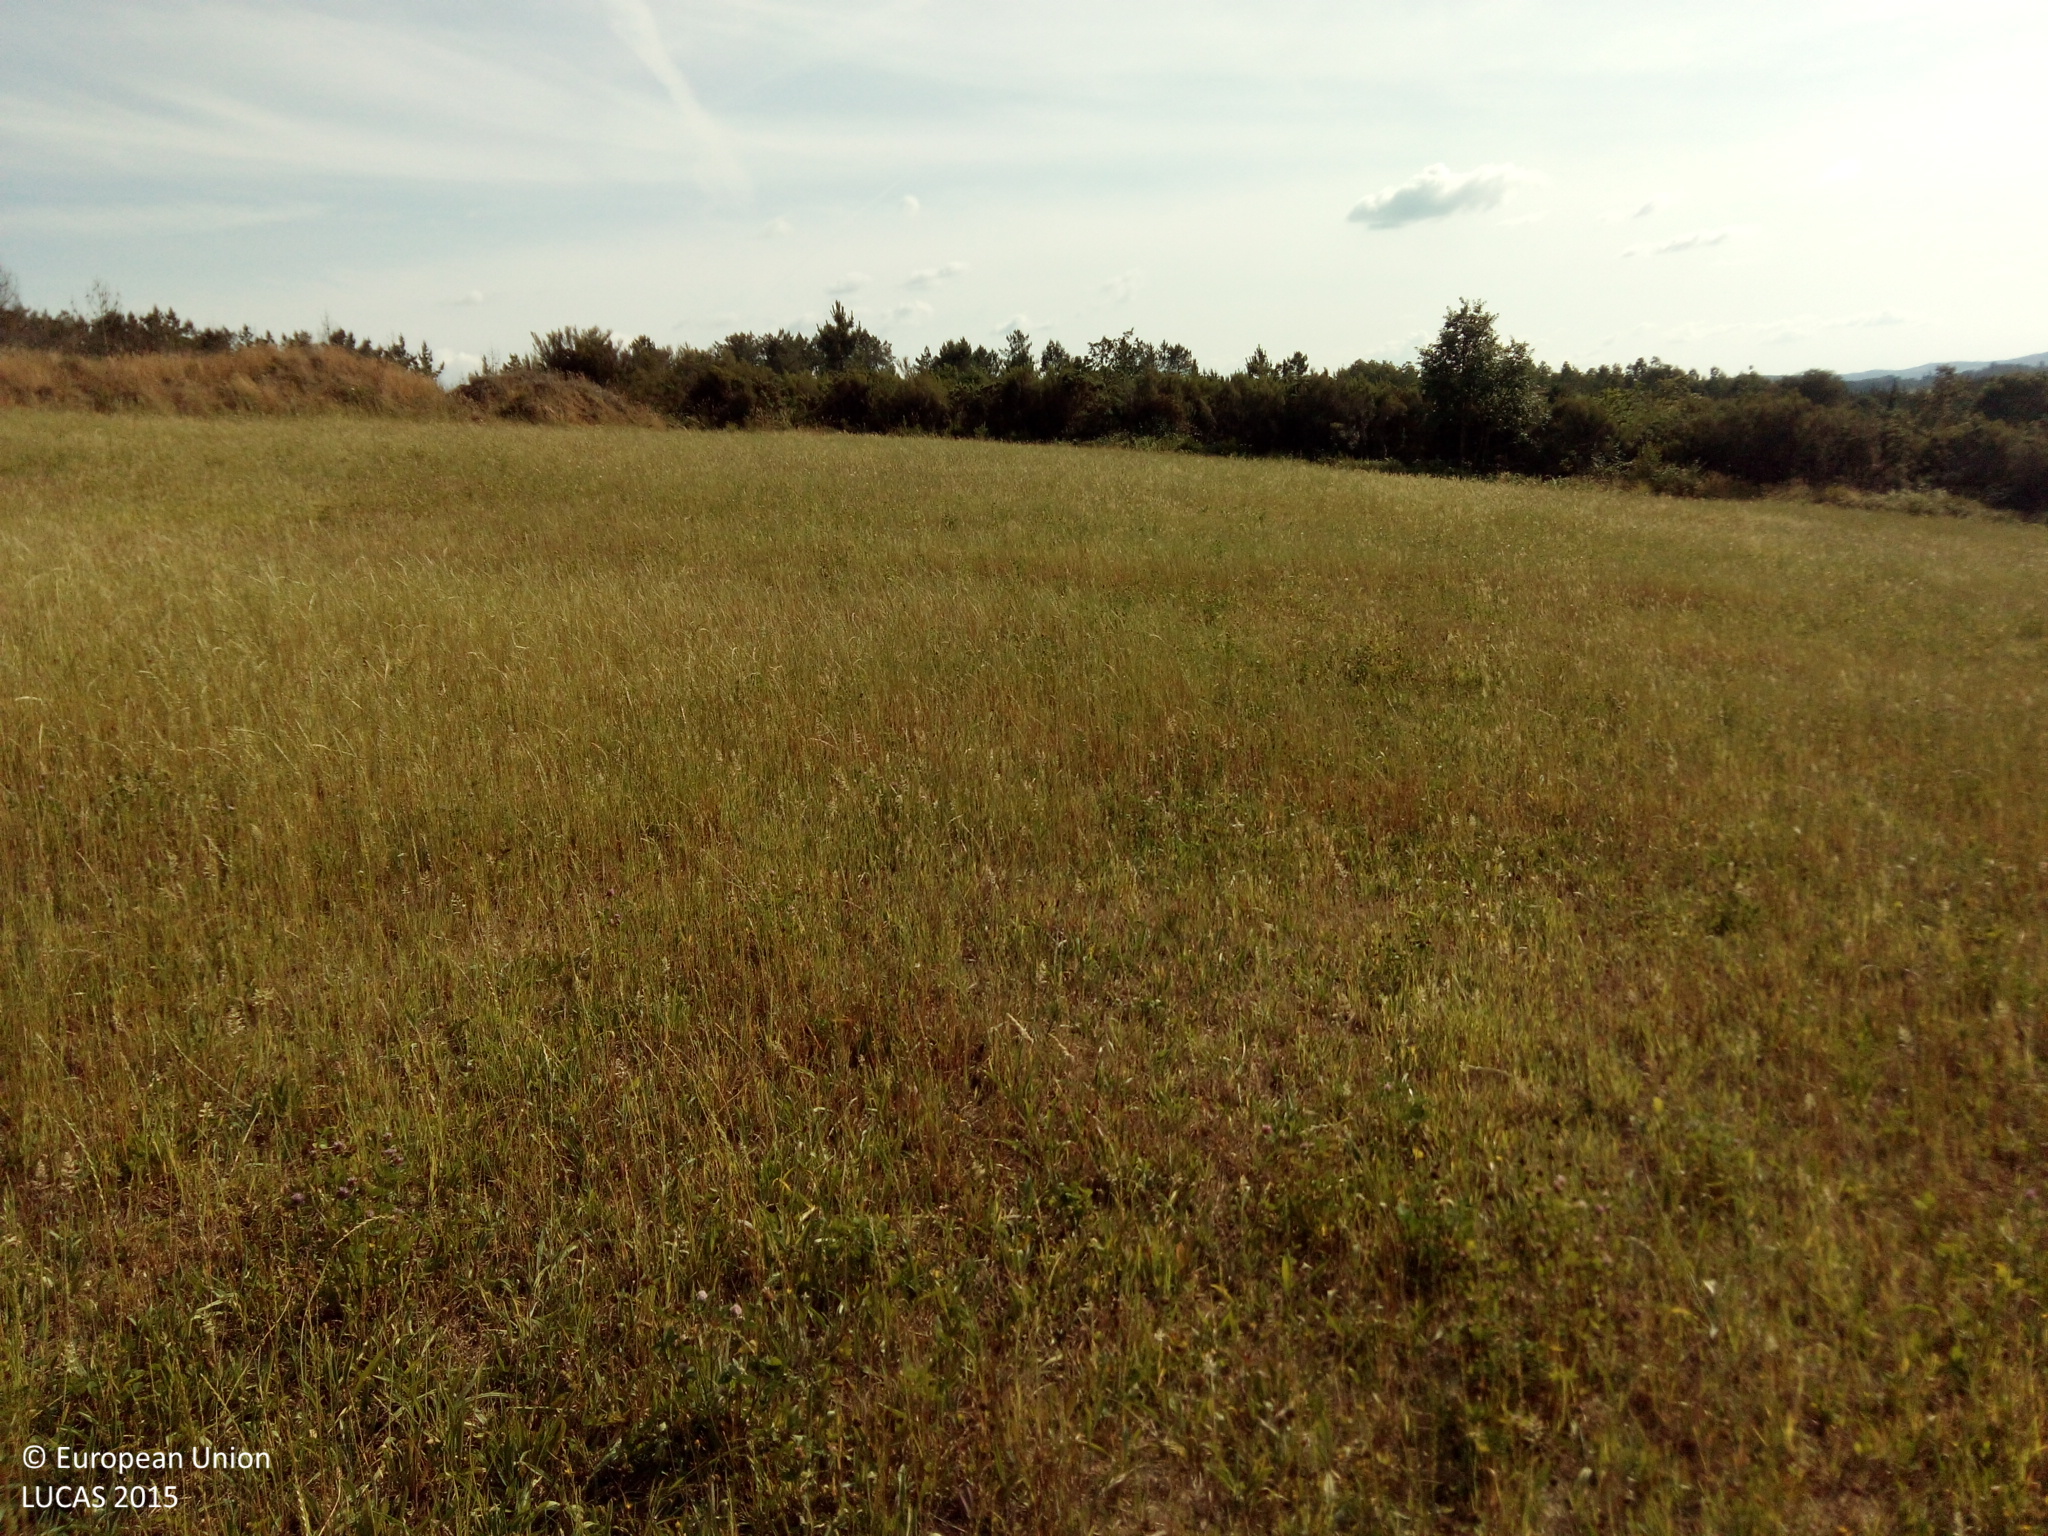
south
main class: Cropland
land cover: Mixed cereals for fodder
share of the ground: > 75 %
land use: Agriculture (excluding fallow land and kitchen gardens)
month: July
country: ES
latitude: 42.8717
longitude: -7.9971
